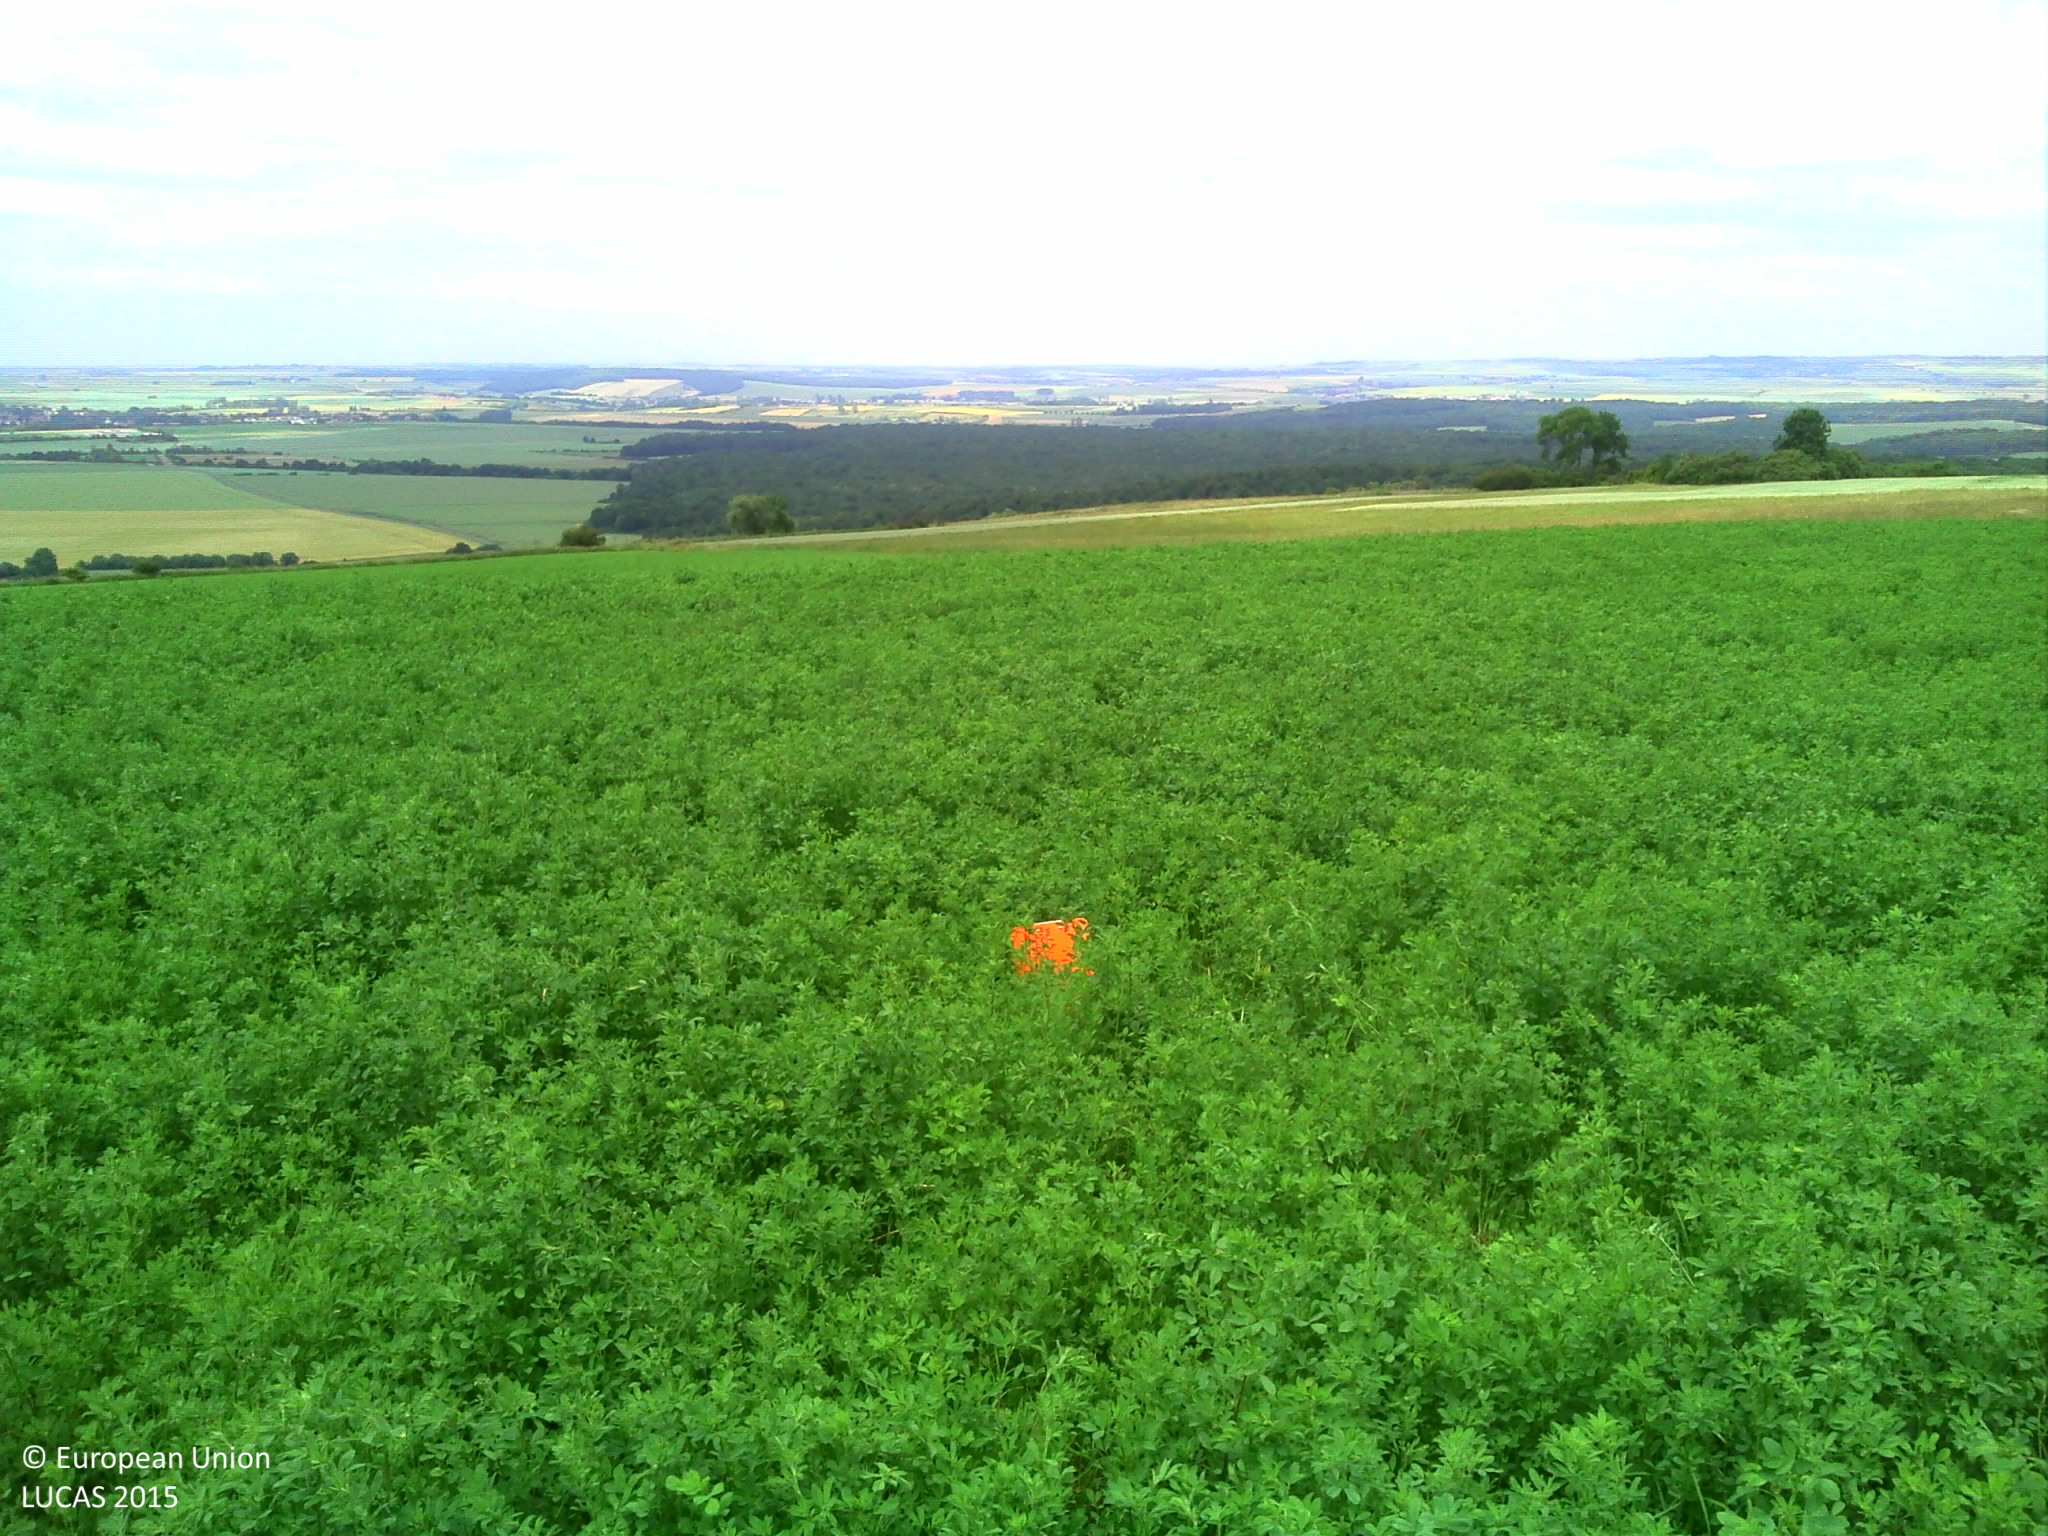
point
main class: Cropland
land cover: Lucerne
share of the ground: > 75 %
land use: Agriculture (excluding fallow land and kitchen gardens)
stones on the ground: 25 - 50 %
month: June
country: FR
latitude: 48.8434
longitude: 6.2255
